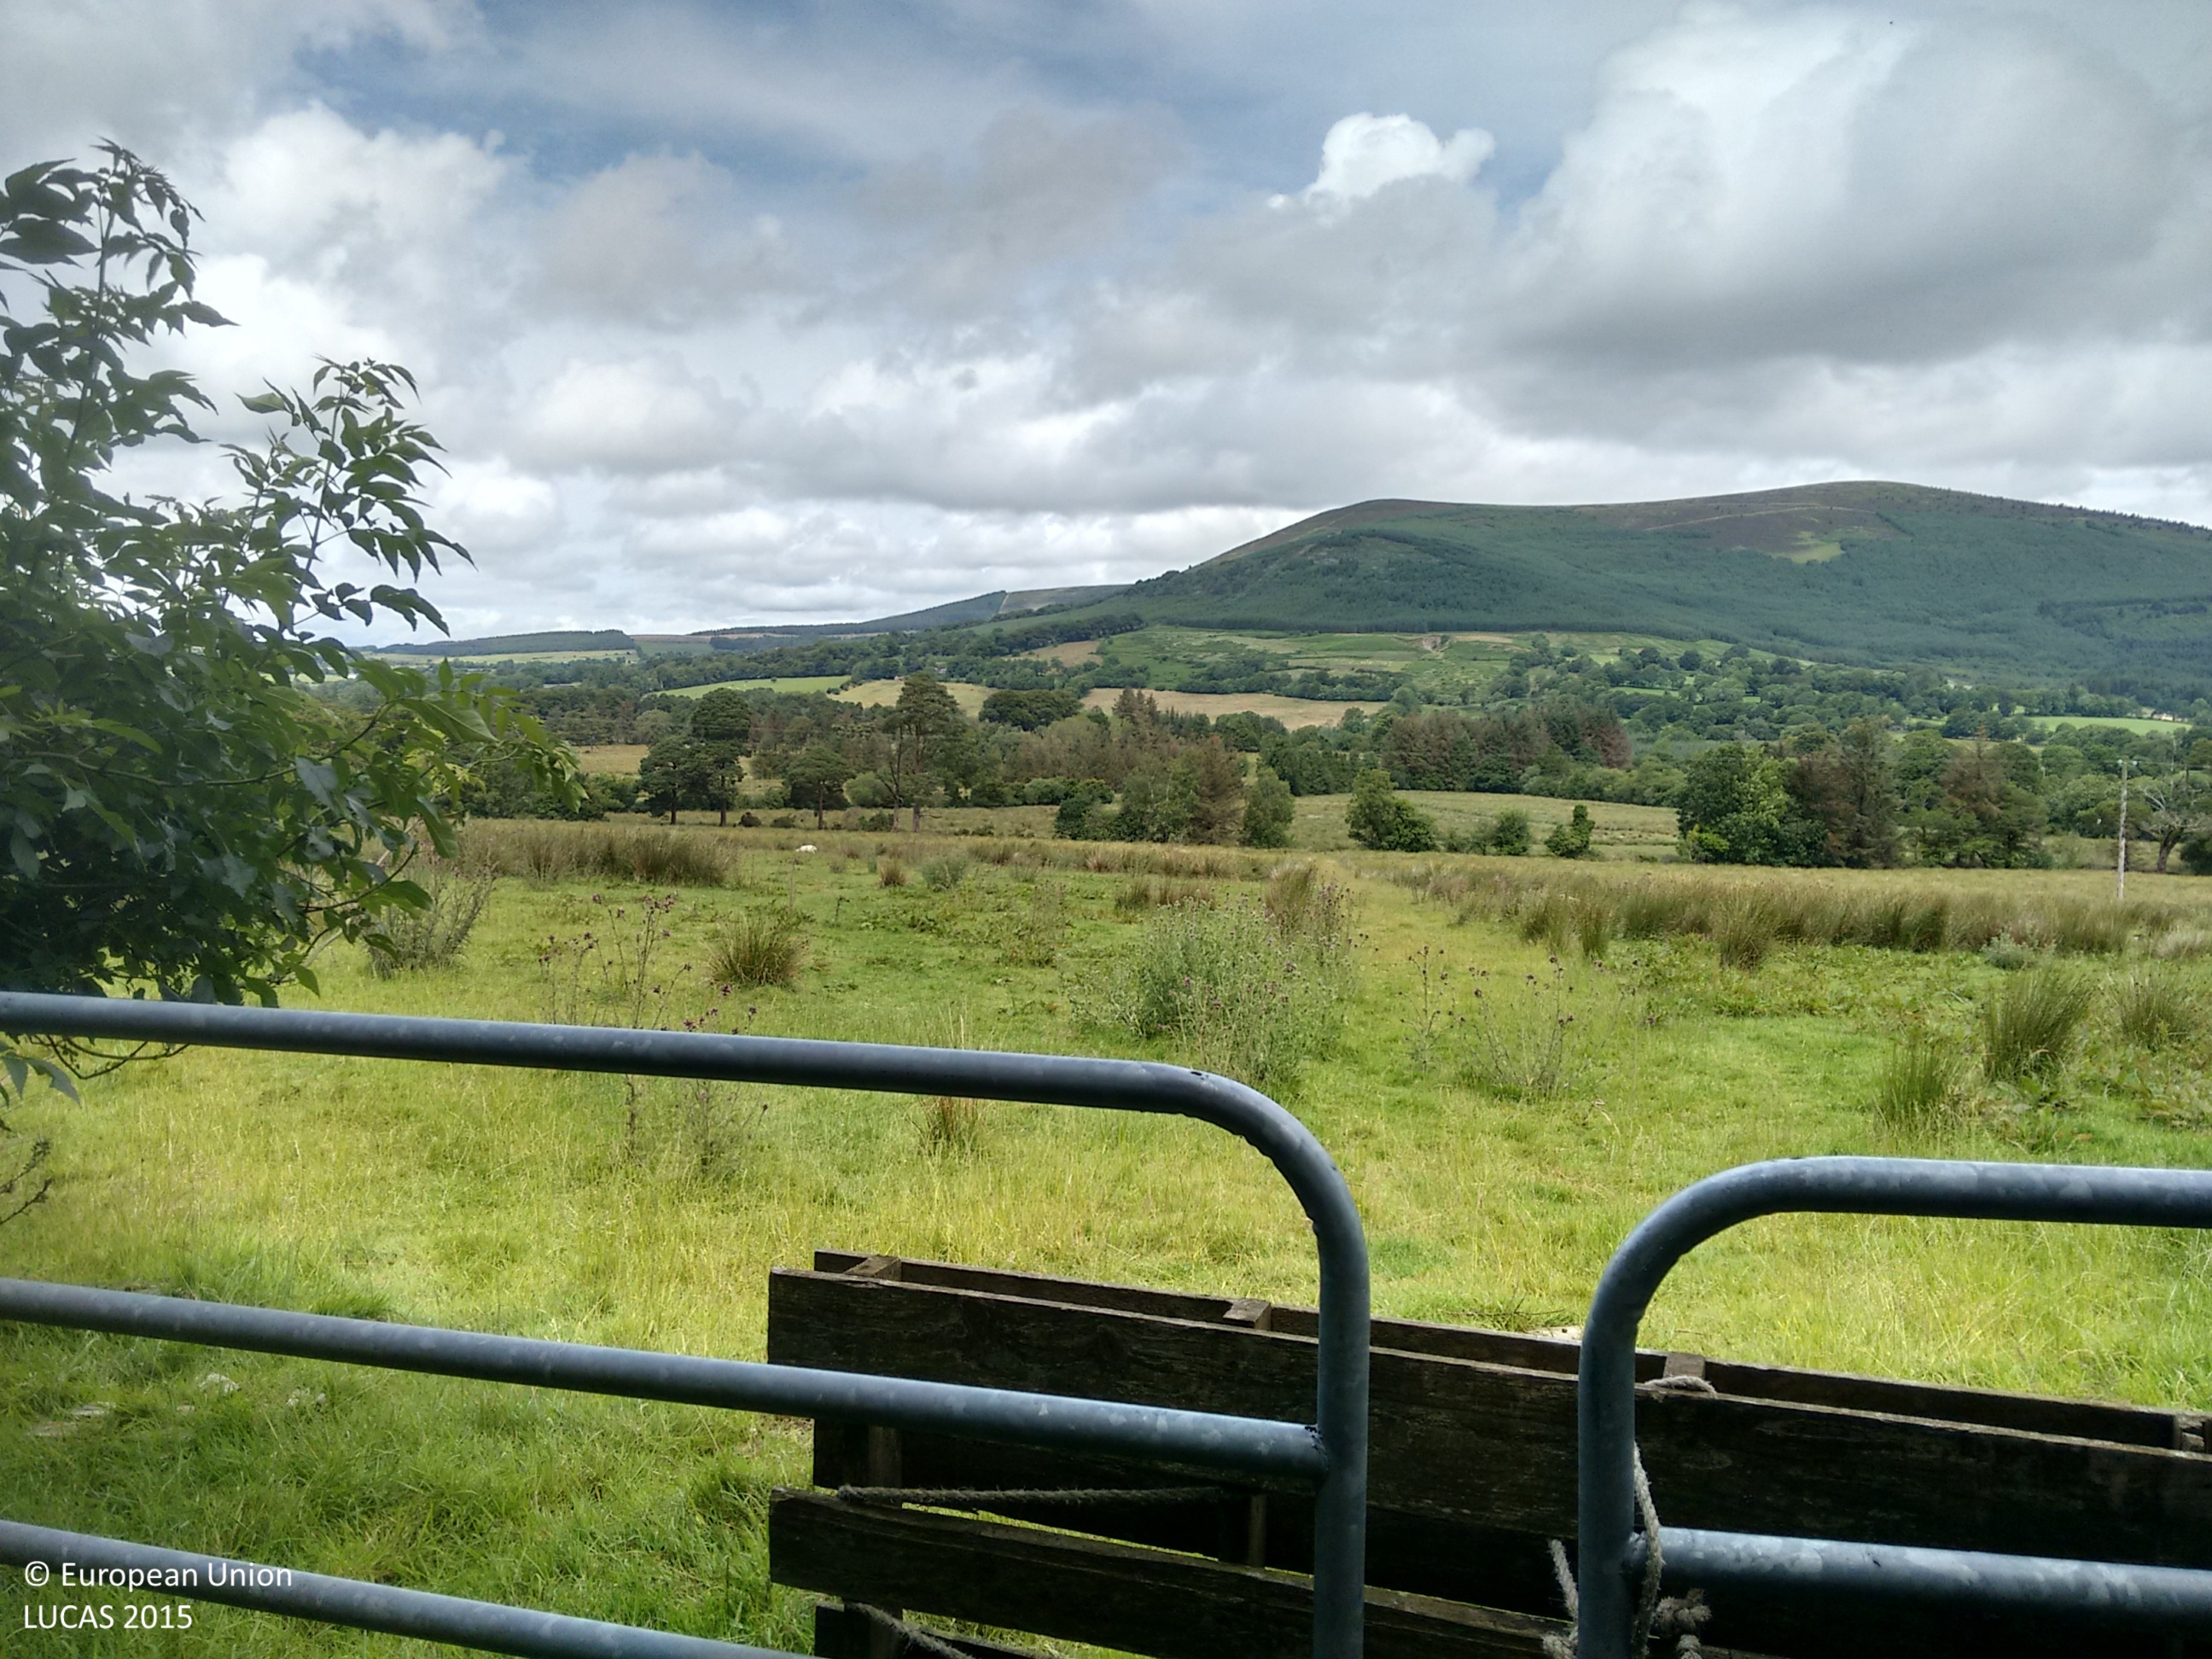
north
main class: Grassland
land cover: Grassland without tree/shrub cover
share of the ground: > 75 %
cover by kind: herbaceous plants 100 %
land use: Agriculture (excluding fallow land and kitchen gardens)
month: July
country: IE
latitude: 52.9853
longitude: -6.5589
